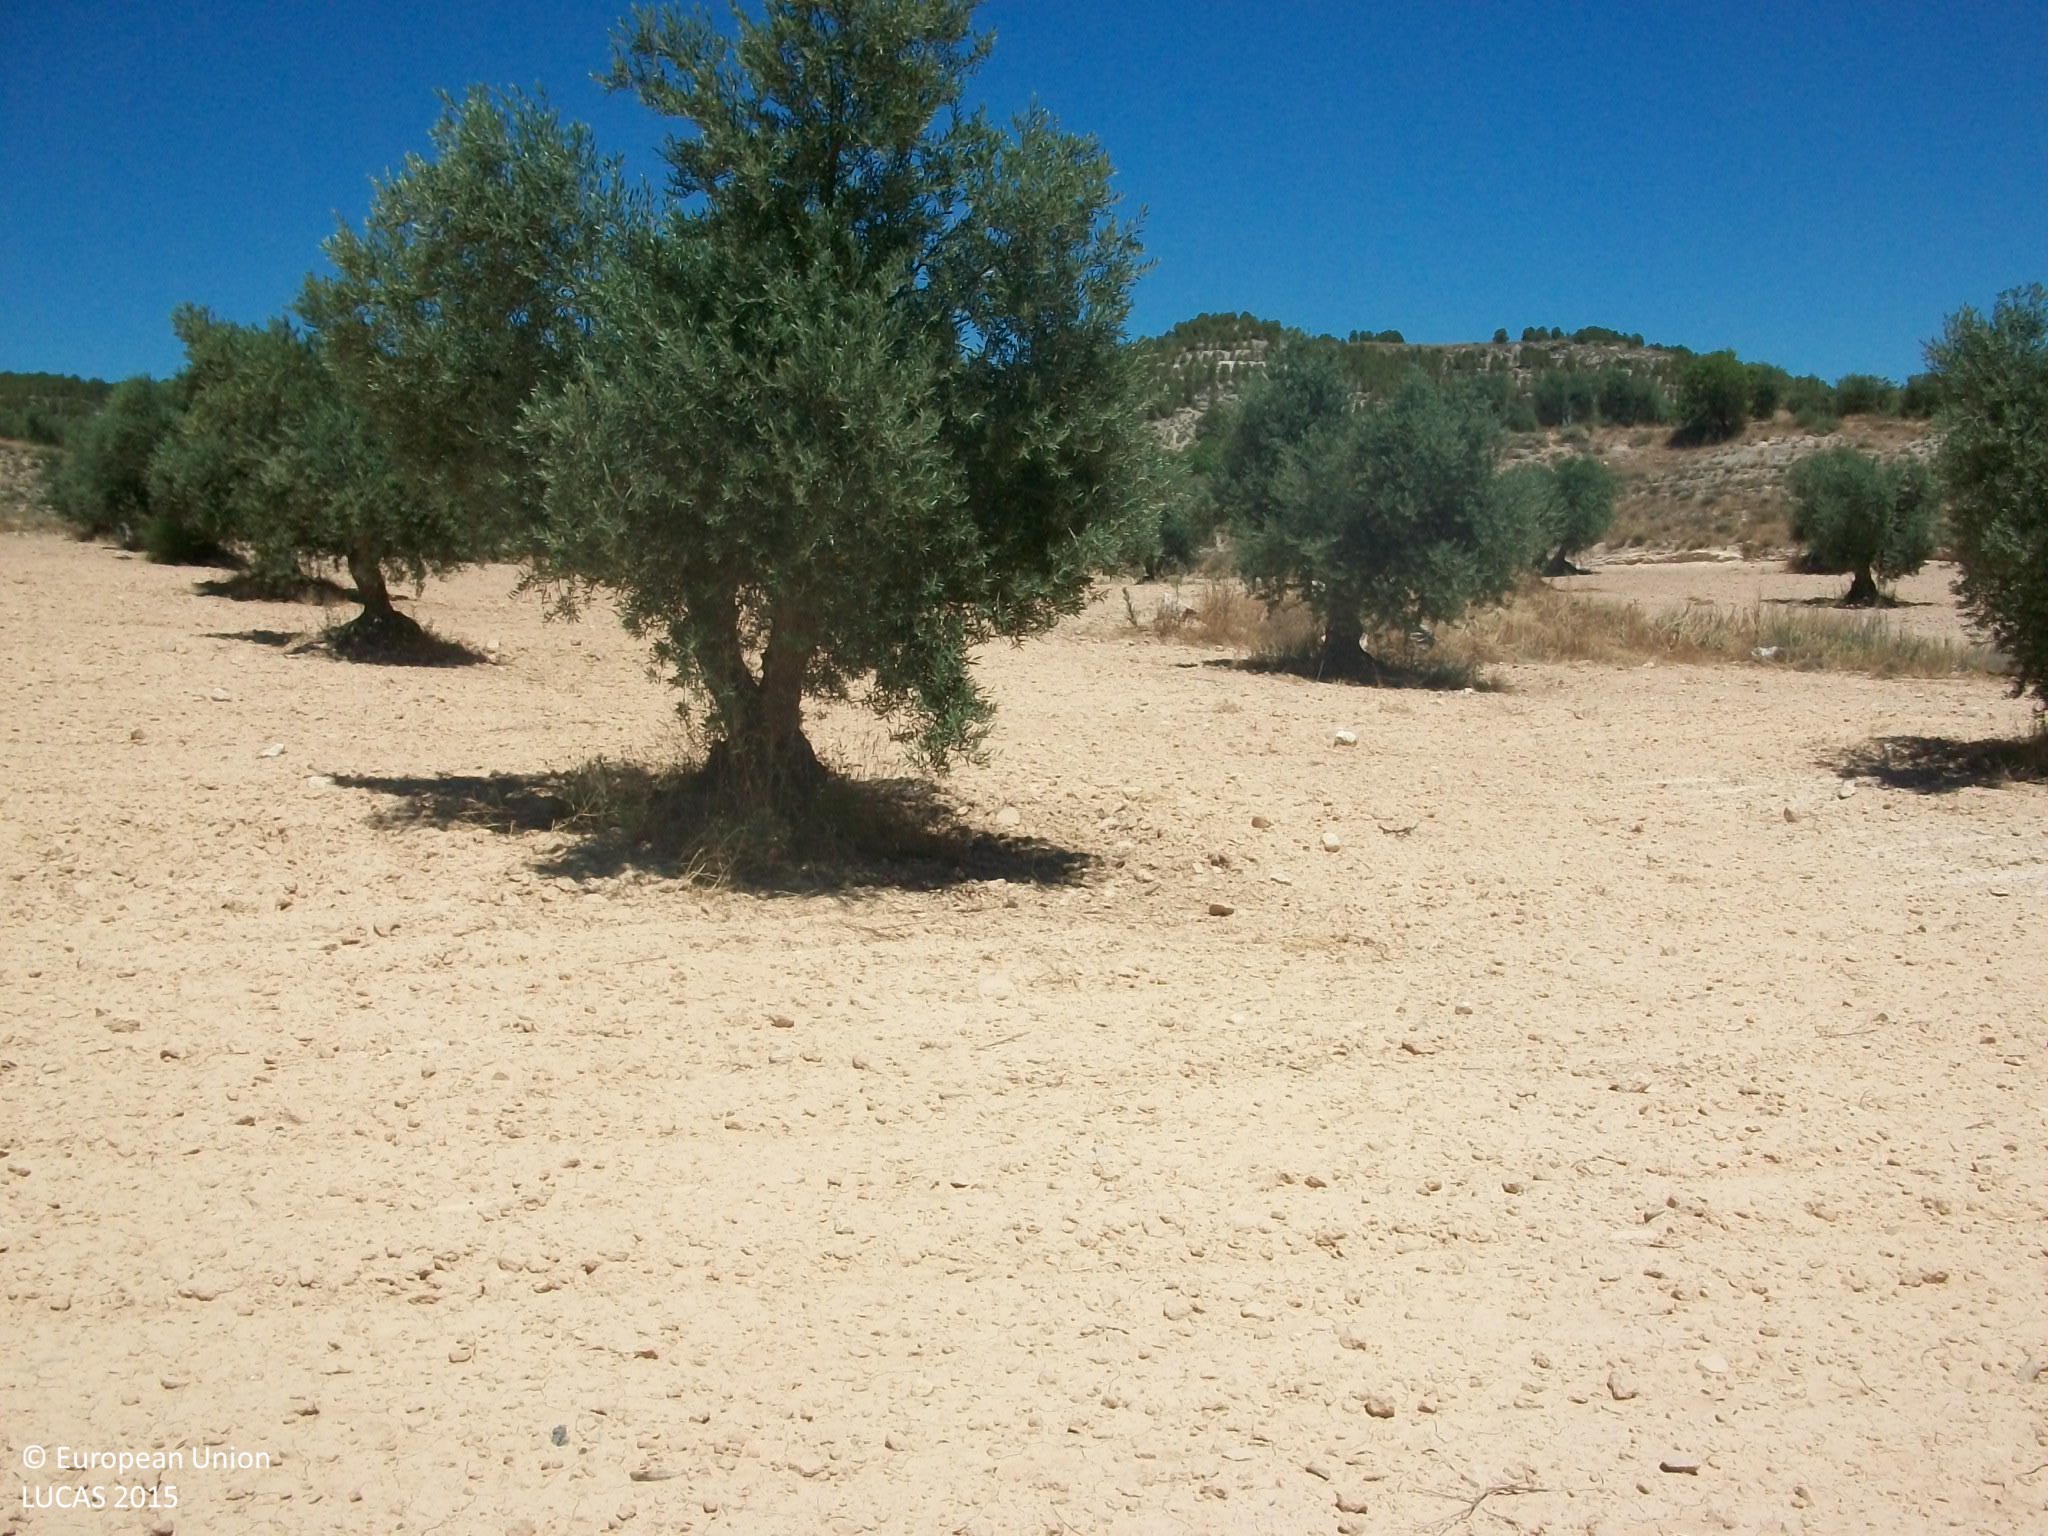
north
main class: Cropland
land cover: Olive groves
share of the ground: 25 - 50 %
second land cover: Other bare soil
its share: > 75 %
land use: Agriculture (excluding fallow land and kitchen gardens)
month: June
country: ES
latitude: 39.9085
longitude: -3.6817
